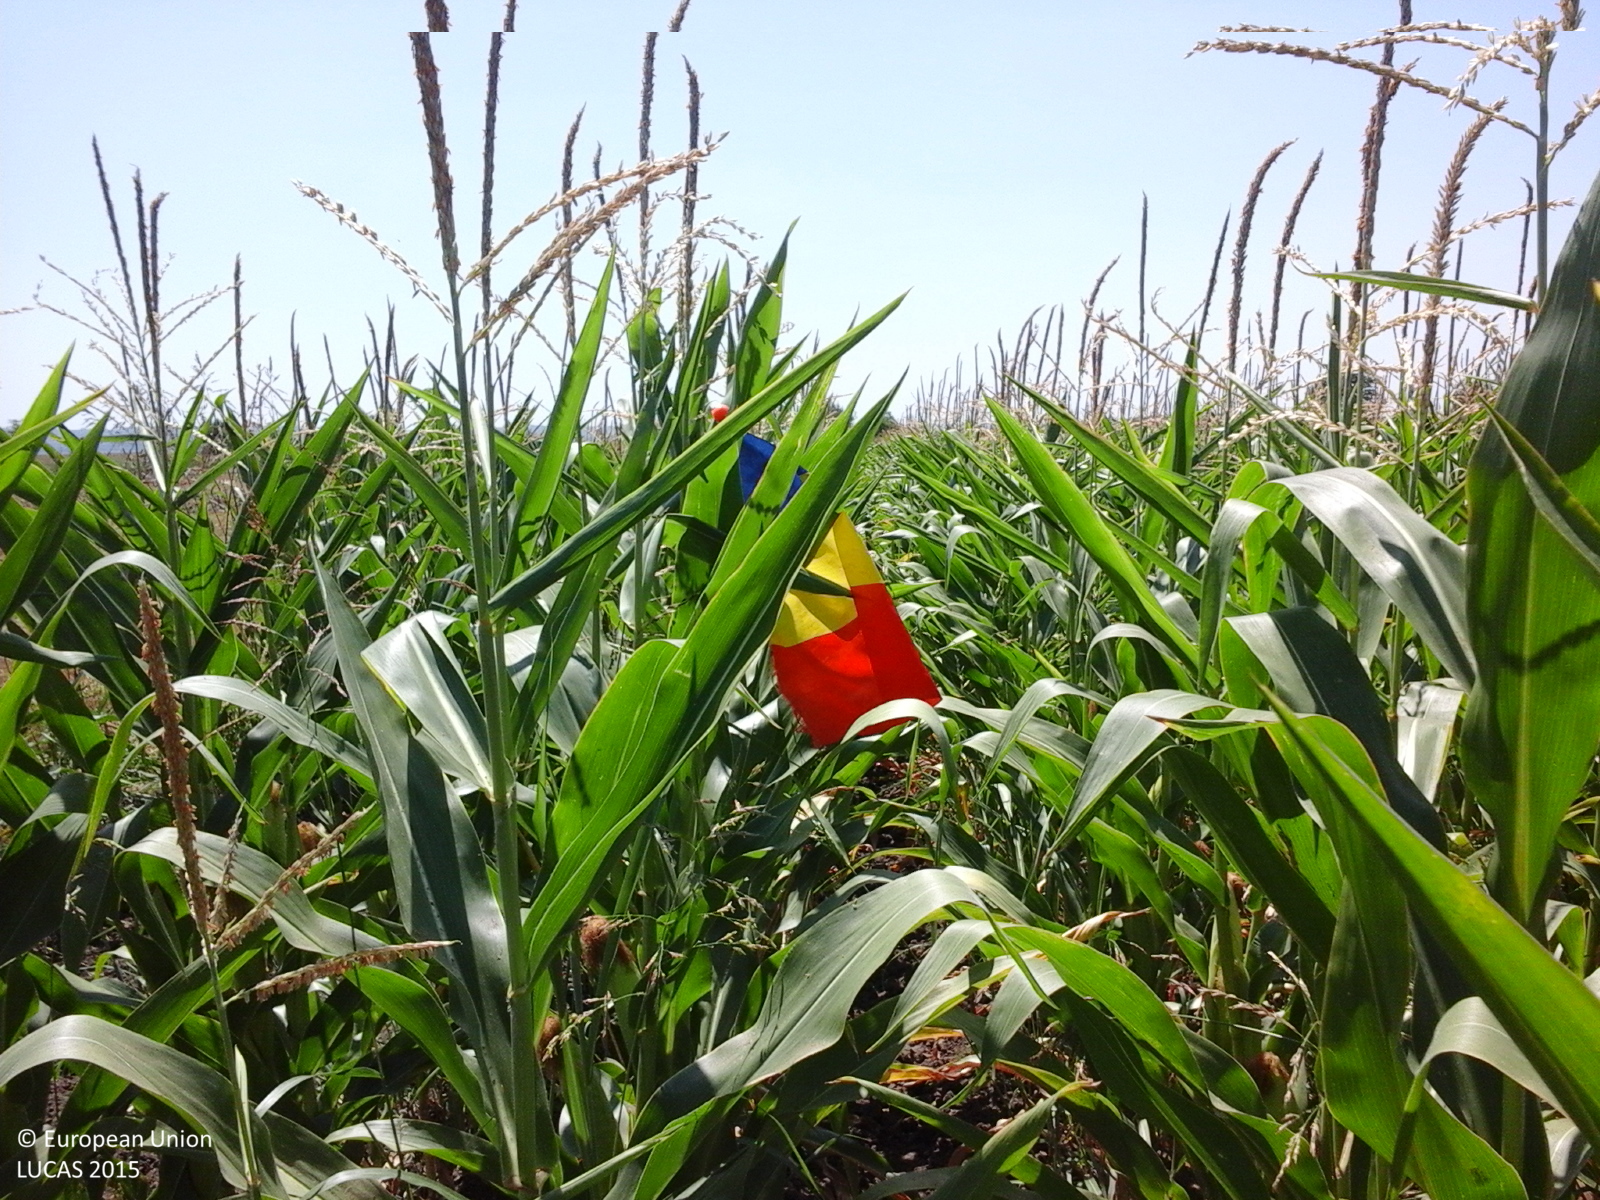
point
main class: Cropland
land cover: Maize
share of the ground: > 75 %
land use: Agriculture (excluding fallow land and kitchen gardens)
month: July
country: RO
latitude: 44.2037
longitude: 27.0069
